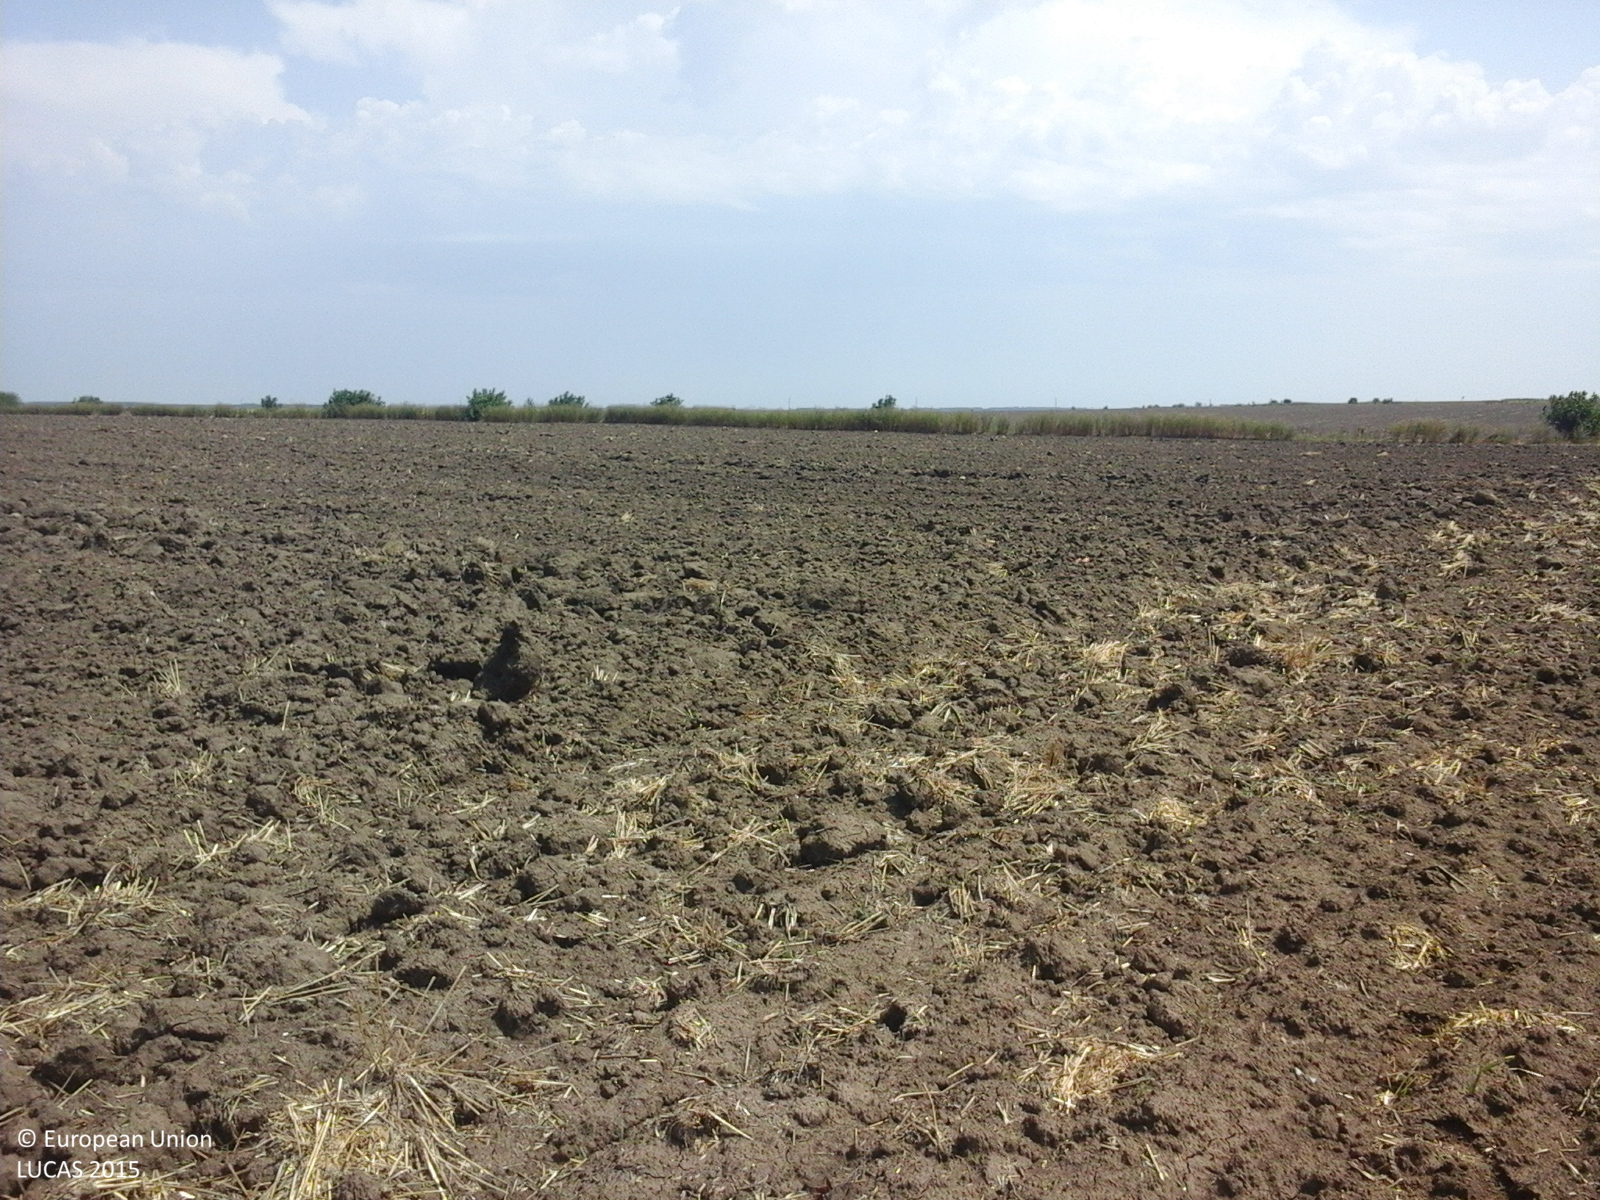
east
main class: Cropland
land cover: Common wheat
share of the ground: < 10 %
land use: Agriculture (excluding fallow land and kitchen gardens)
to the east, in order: Common wheat; Ditches and canals; Common wheat
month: August
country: RO
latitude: 43.9317
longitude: 28.3613
